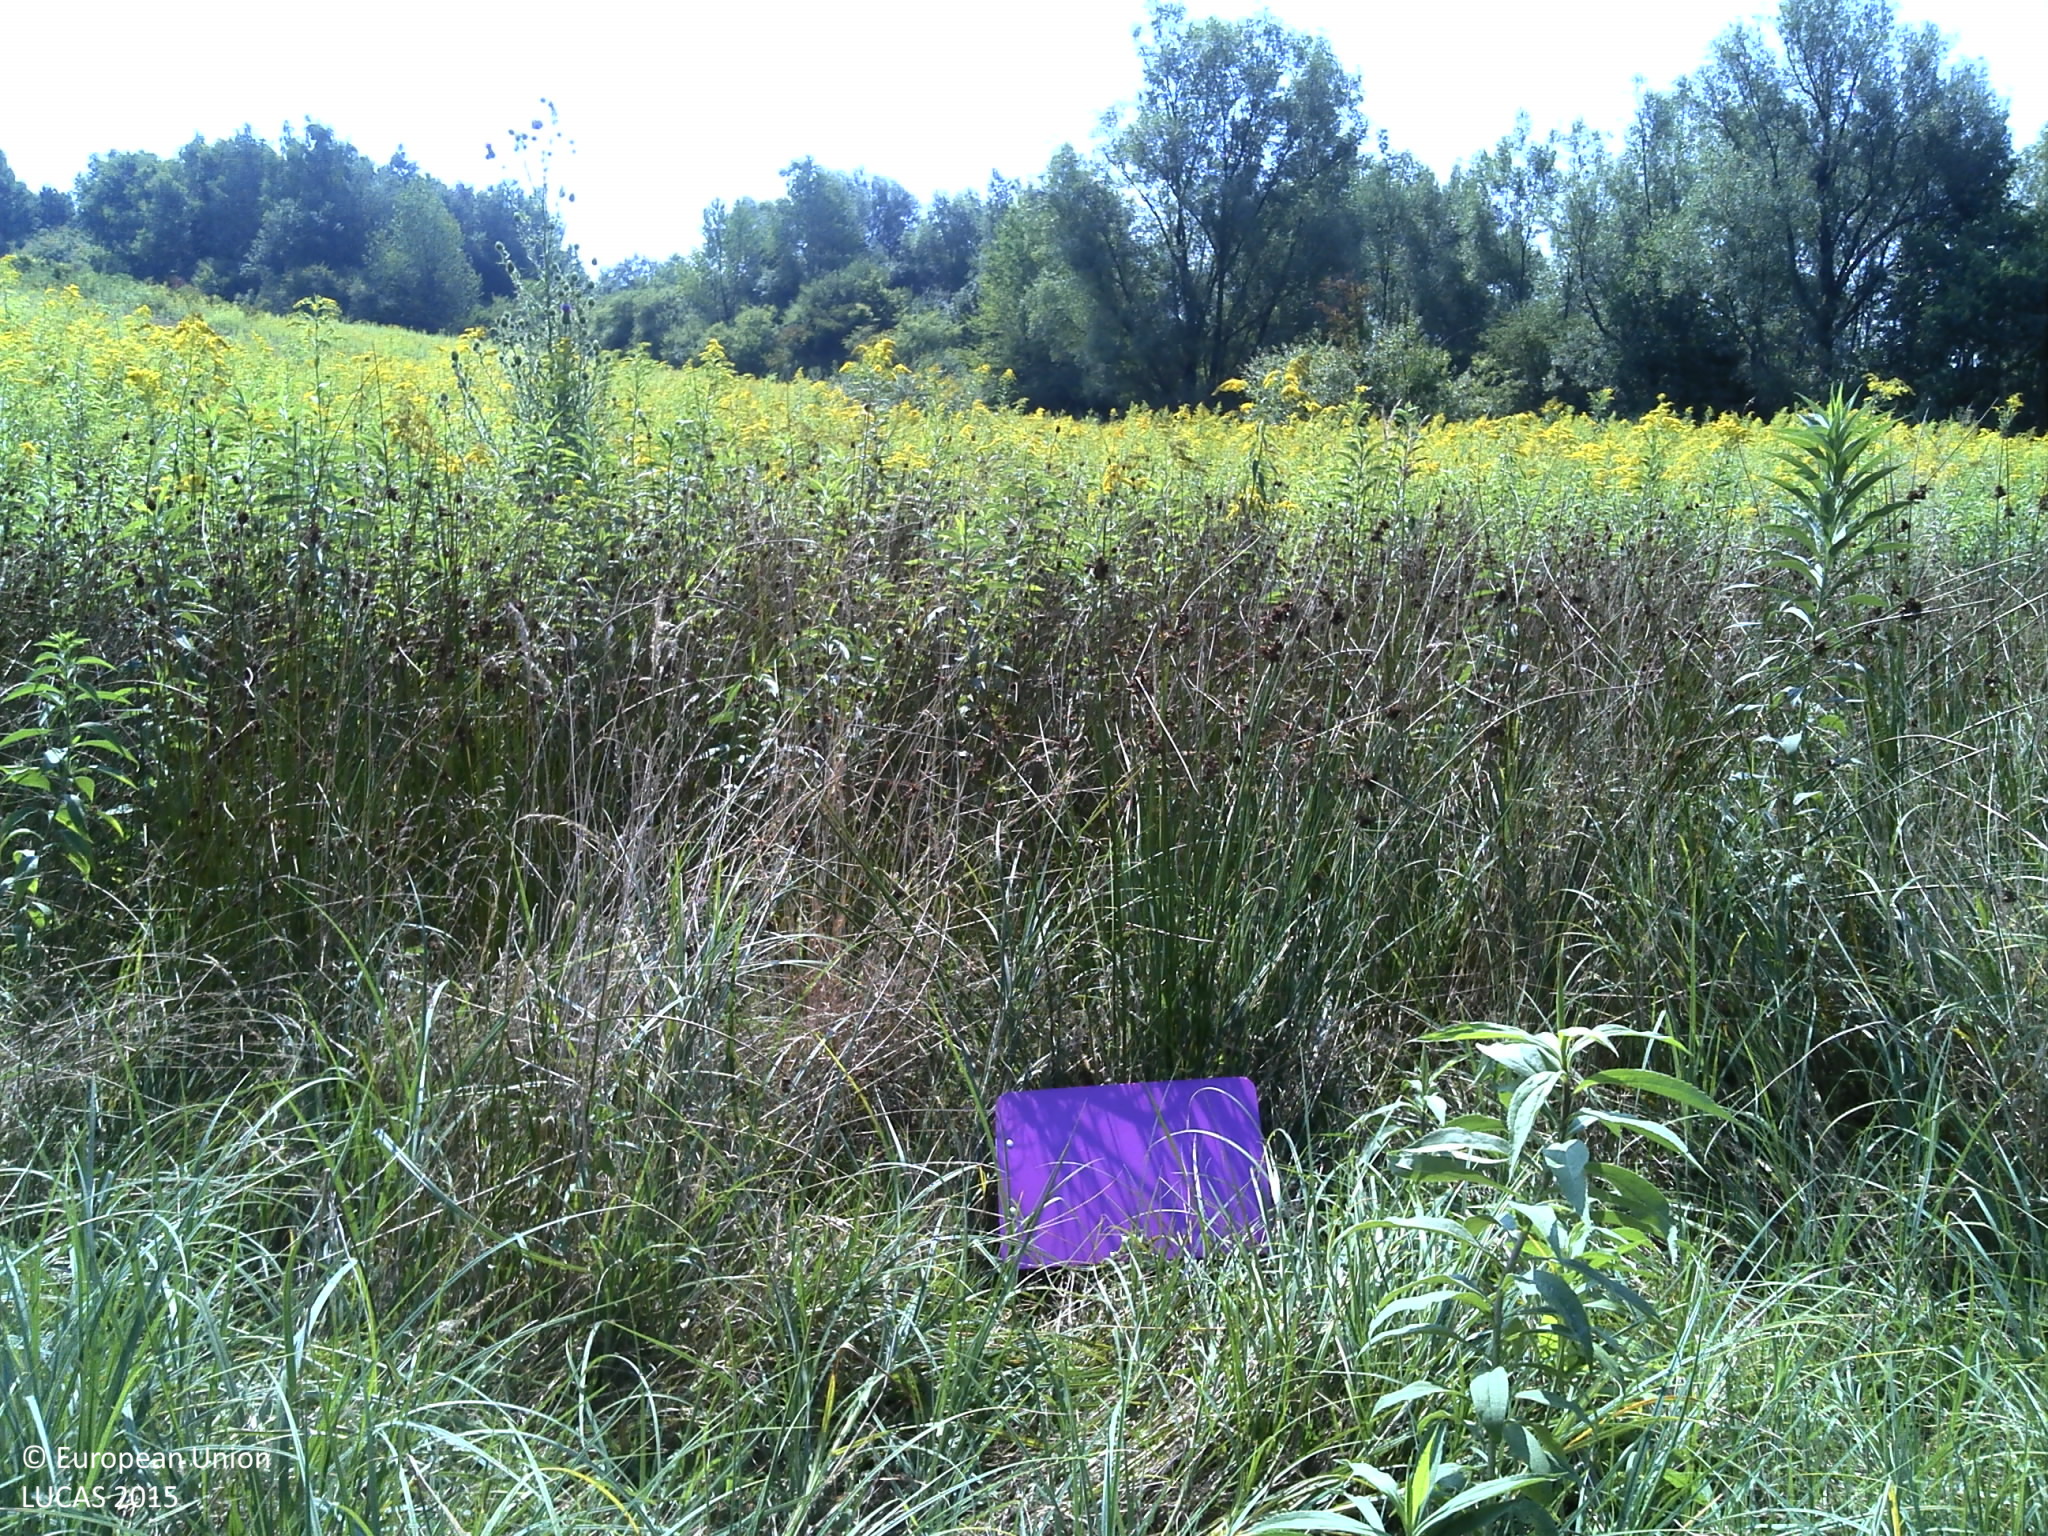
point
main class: Grassland
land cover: Spontaneously vegetated surfaces
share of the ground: > 75 %
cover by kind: herbaceous plants 100 %
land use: Agriculture (excluding fallow land and kitchen gardens)
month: August
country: HR
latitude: 45.5692
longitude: 16.8803
